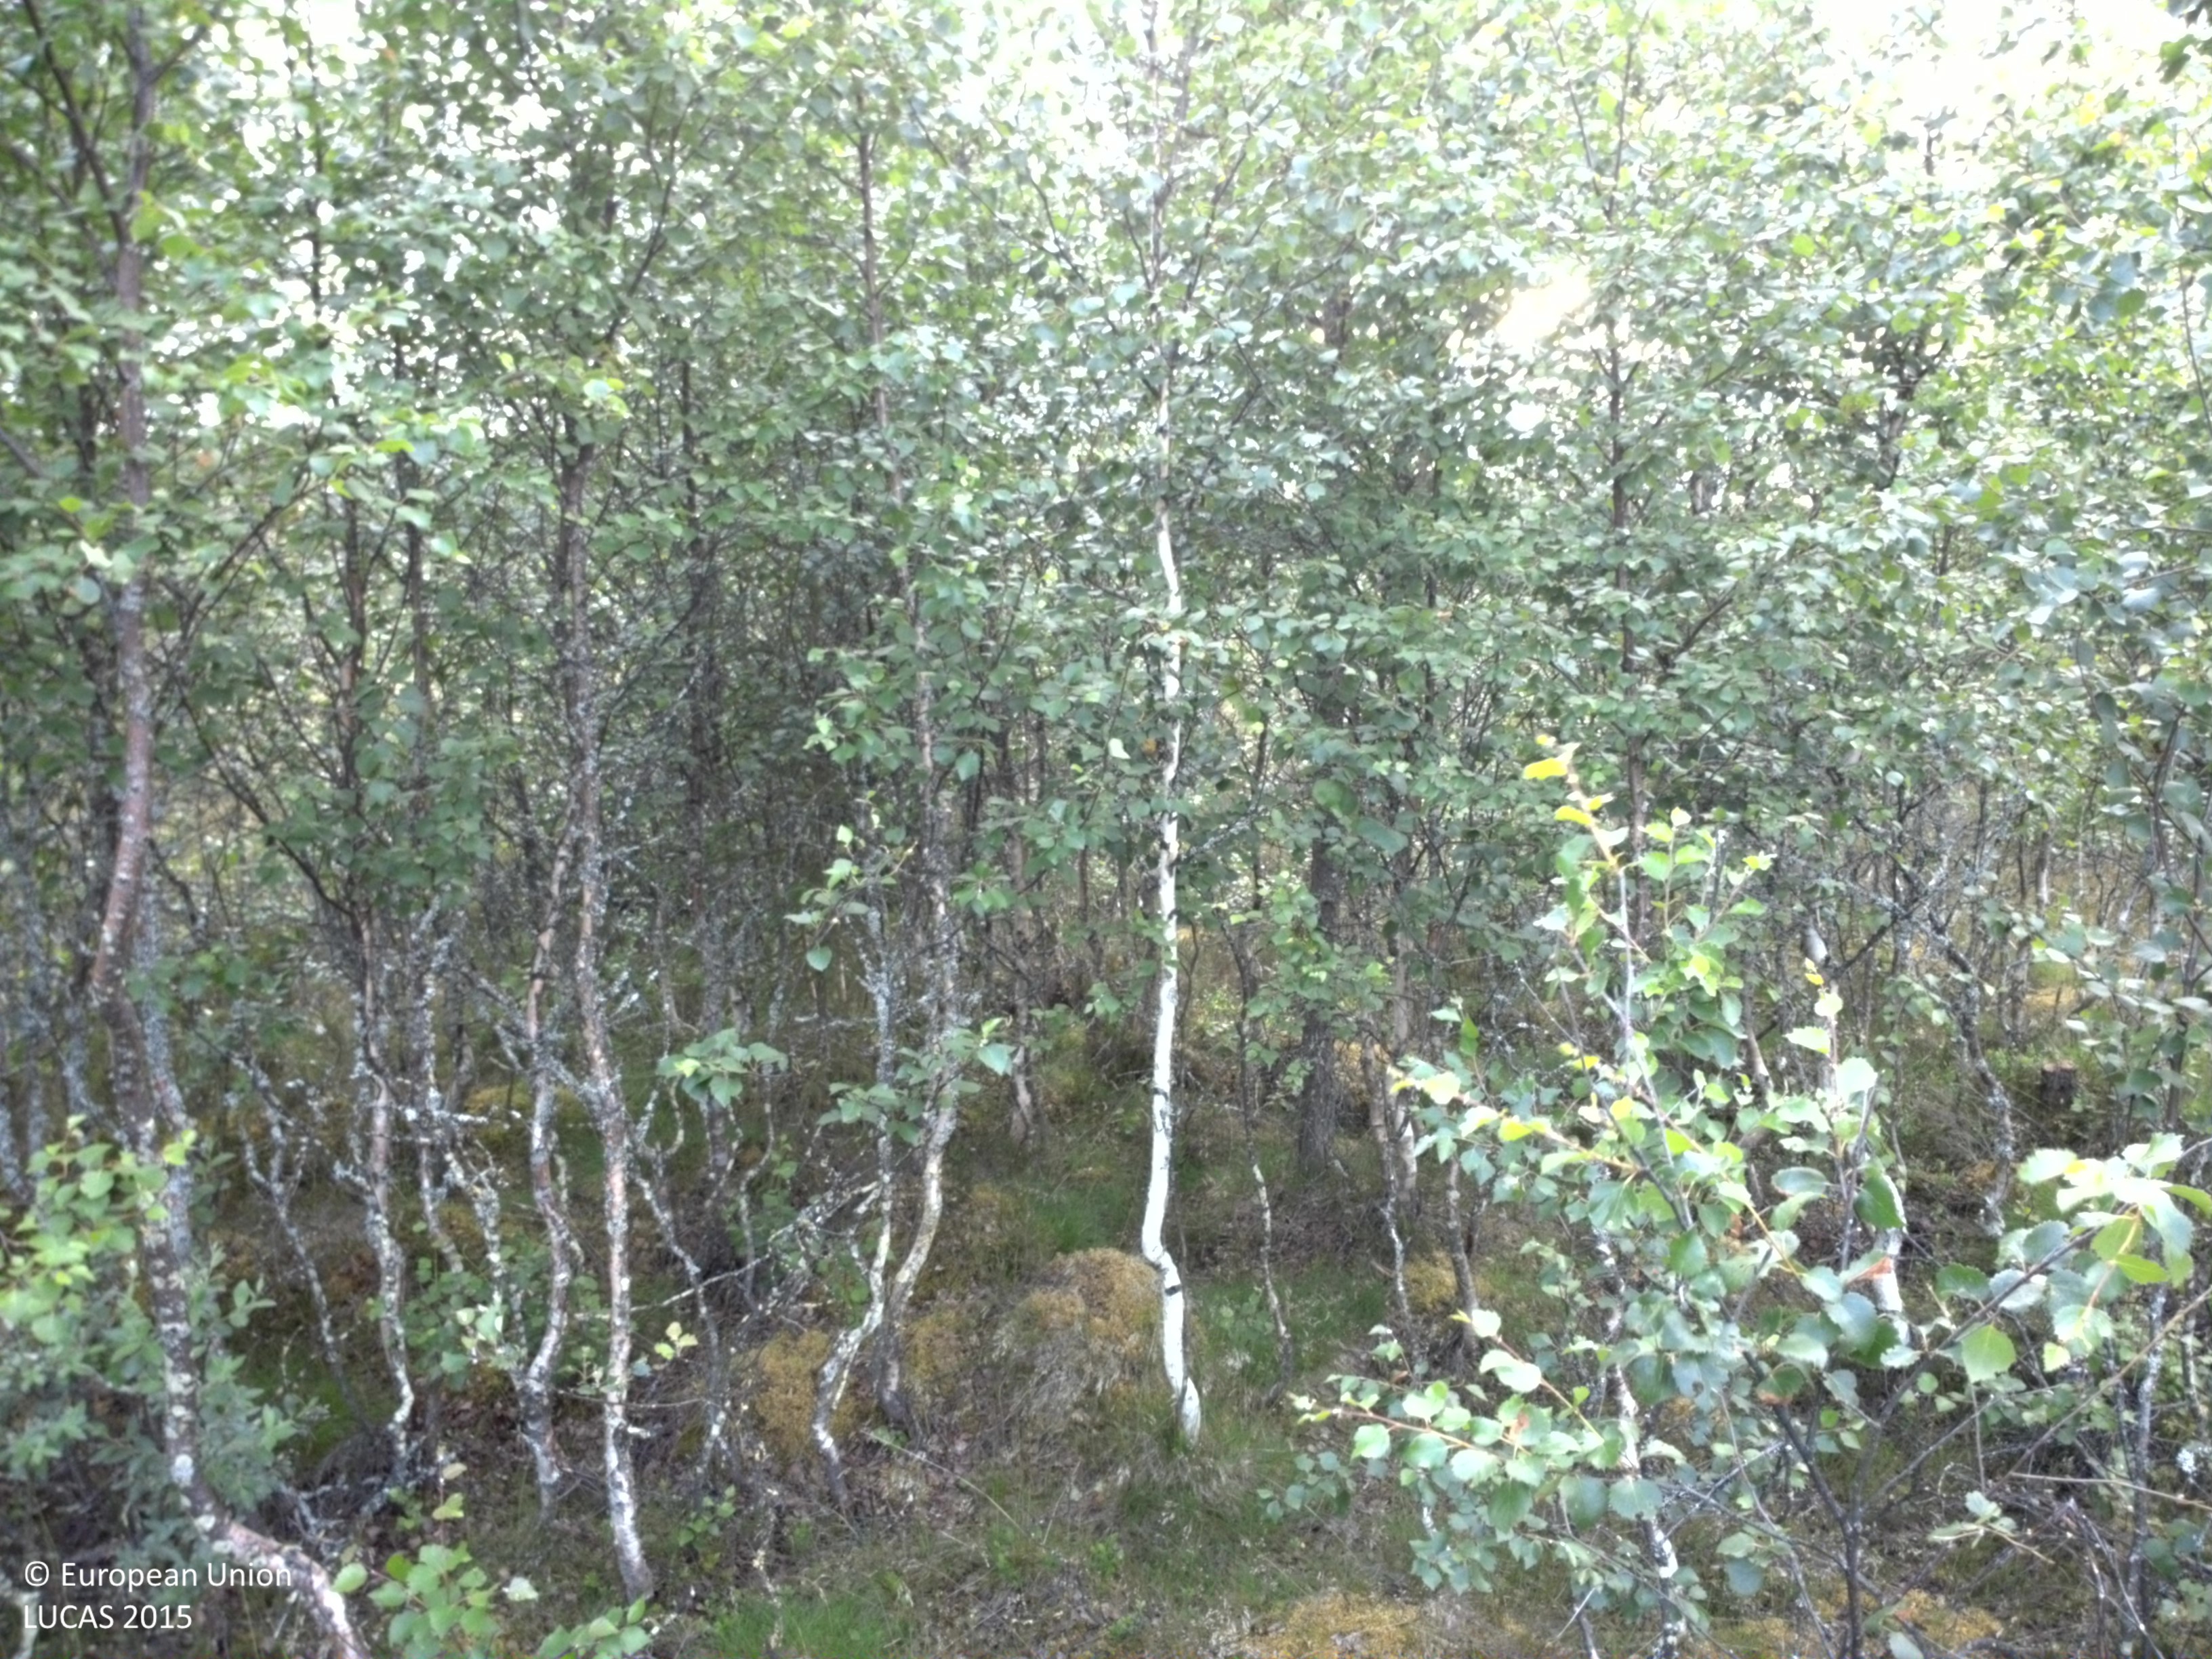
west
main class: Woodland
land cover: Broadleaved woodland
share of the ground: 50 - 75 %
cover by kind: broadleaved forest trees 70 %, shrubs 20 %, lichens and mosses 10 %
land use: Forestry
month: July
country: SE
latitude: 61.6115
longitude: 13.6631
